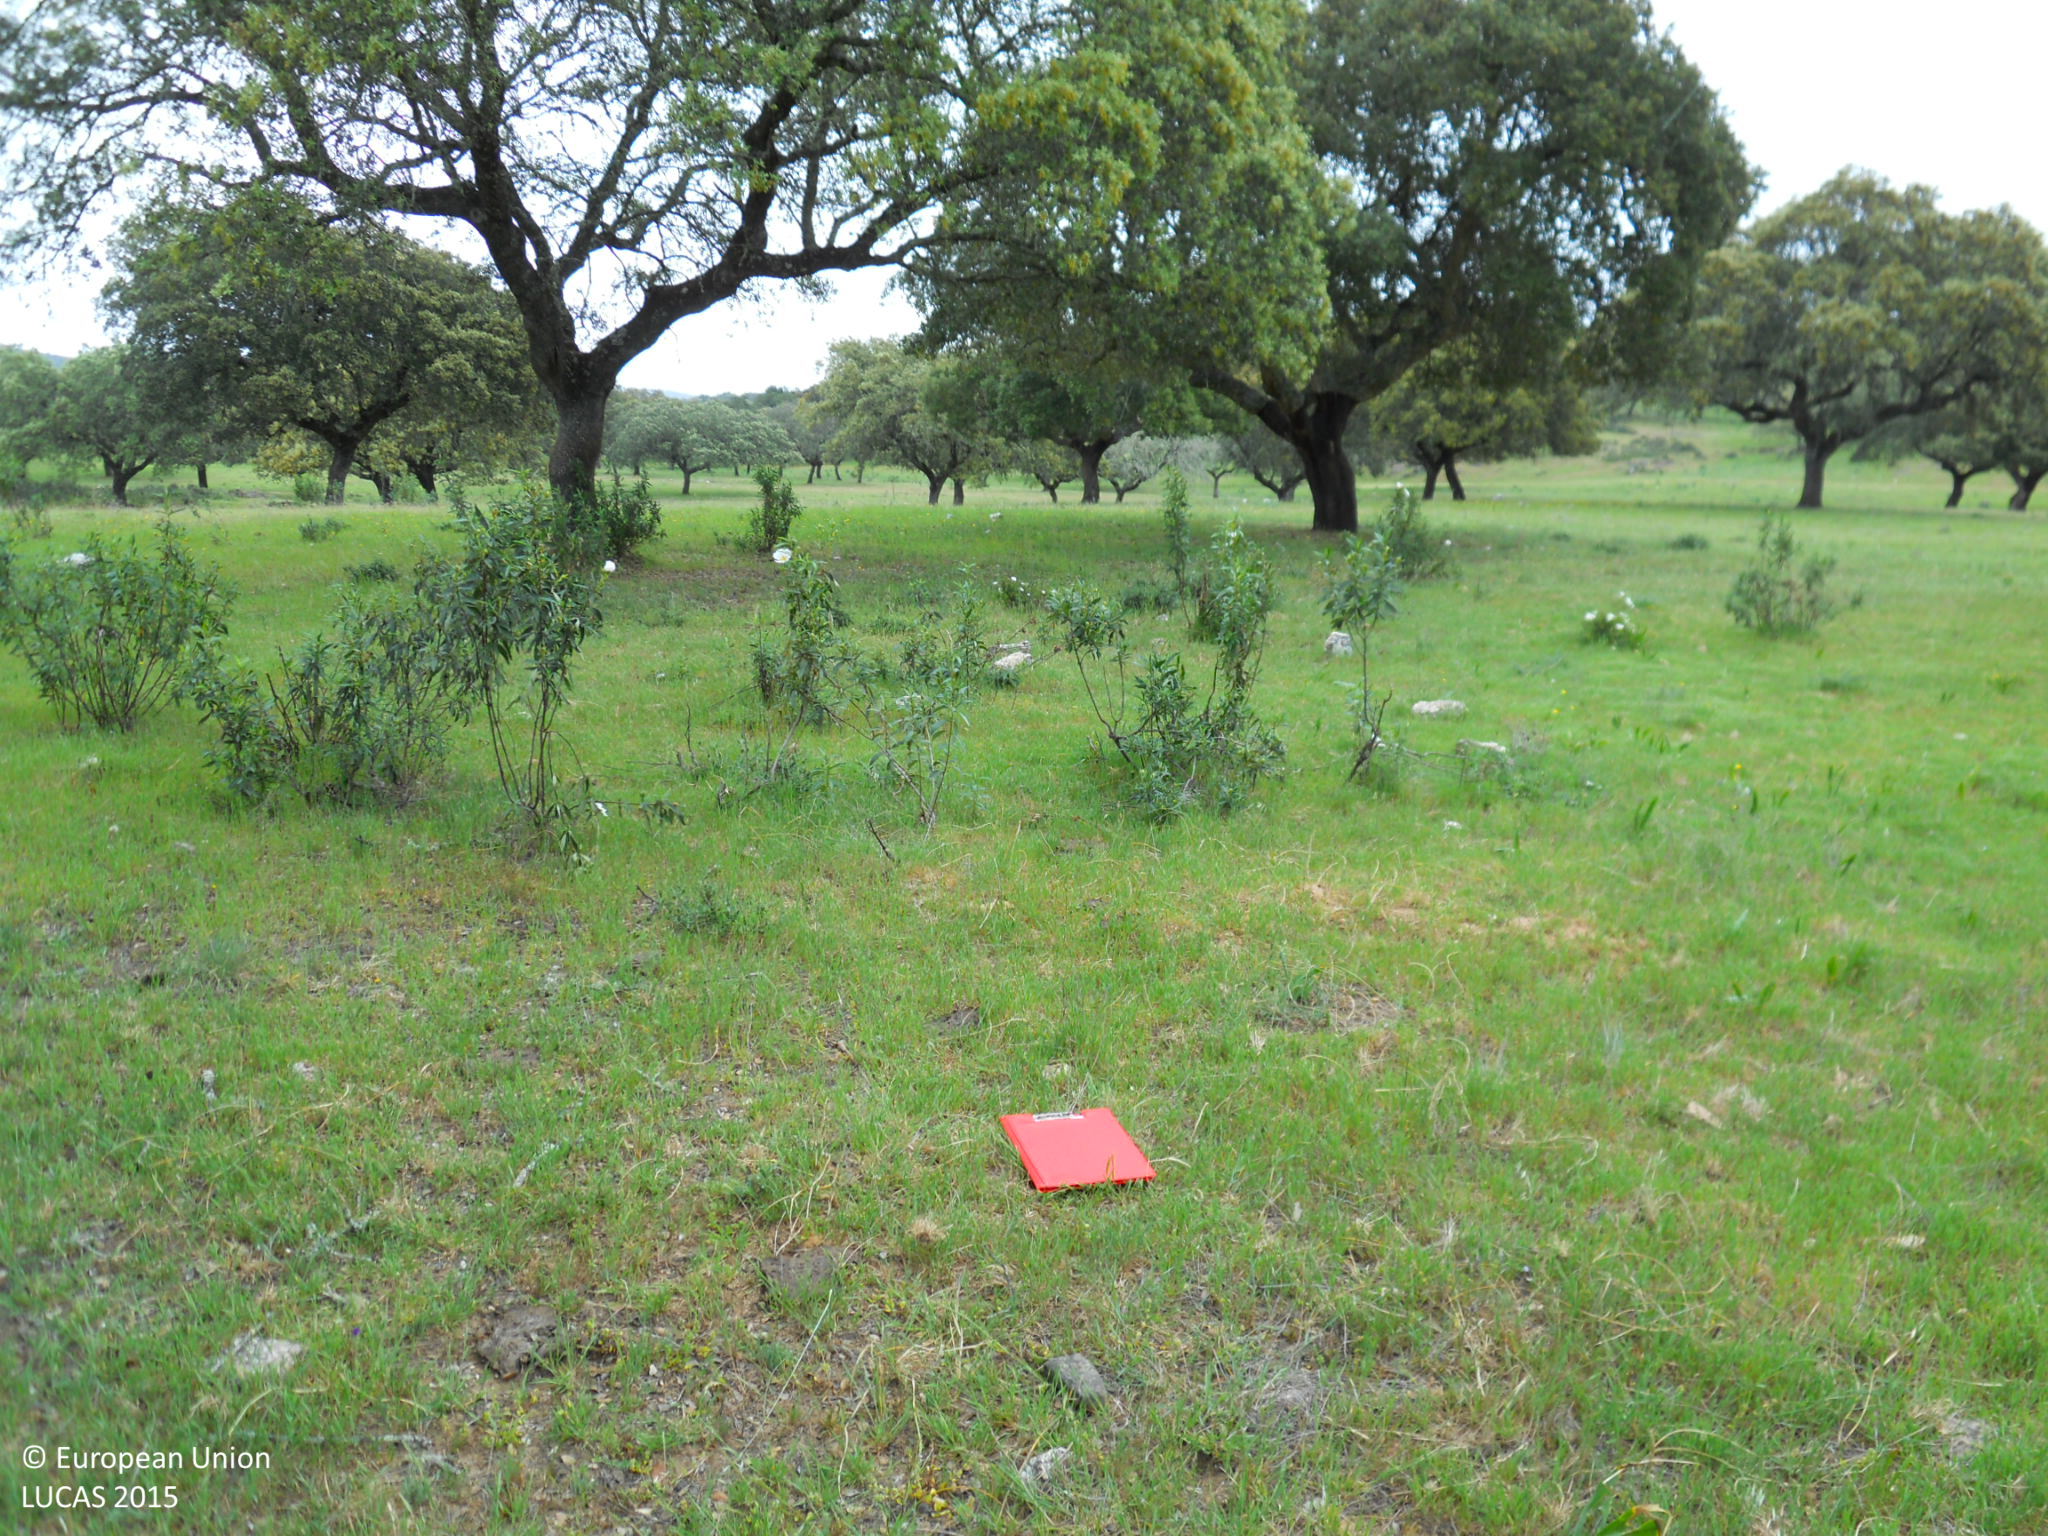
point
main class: Woodland
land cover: Broadleaved woodland
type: broadleaved evergreen forest
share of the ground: > 75 %
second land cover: Grassland without tree/shrub cover
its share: > 75 %
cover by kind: broadleaved forest trees 50 %, herbaceous plants 50 %
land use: Forestry
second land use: Agriculture (excluding fallow land and kitchen gardens)
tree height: > 5 m
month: April
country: ES
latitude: 39.1371
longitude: -6.5989
